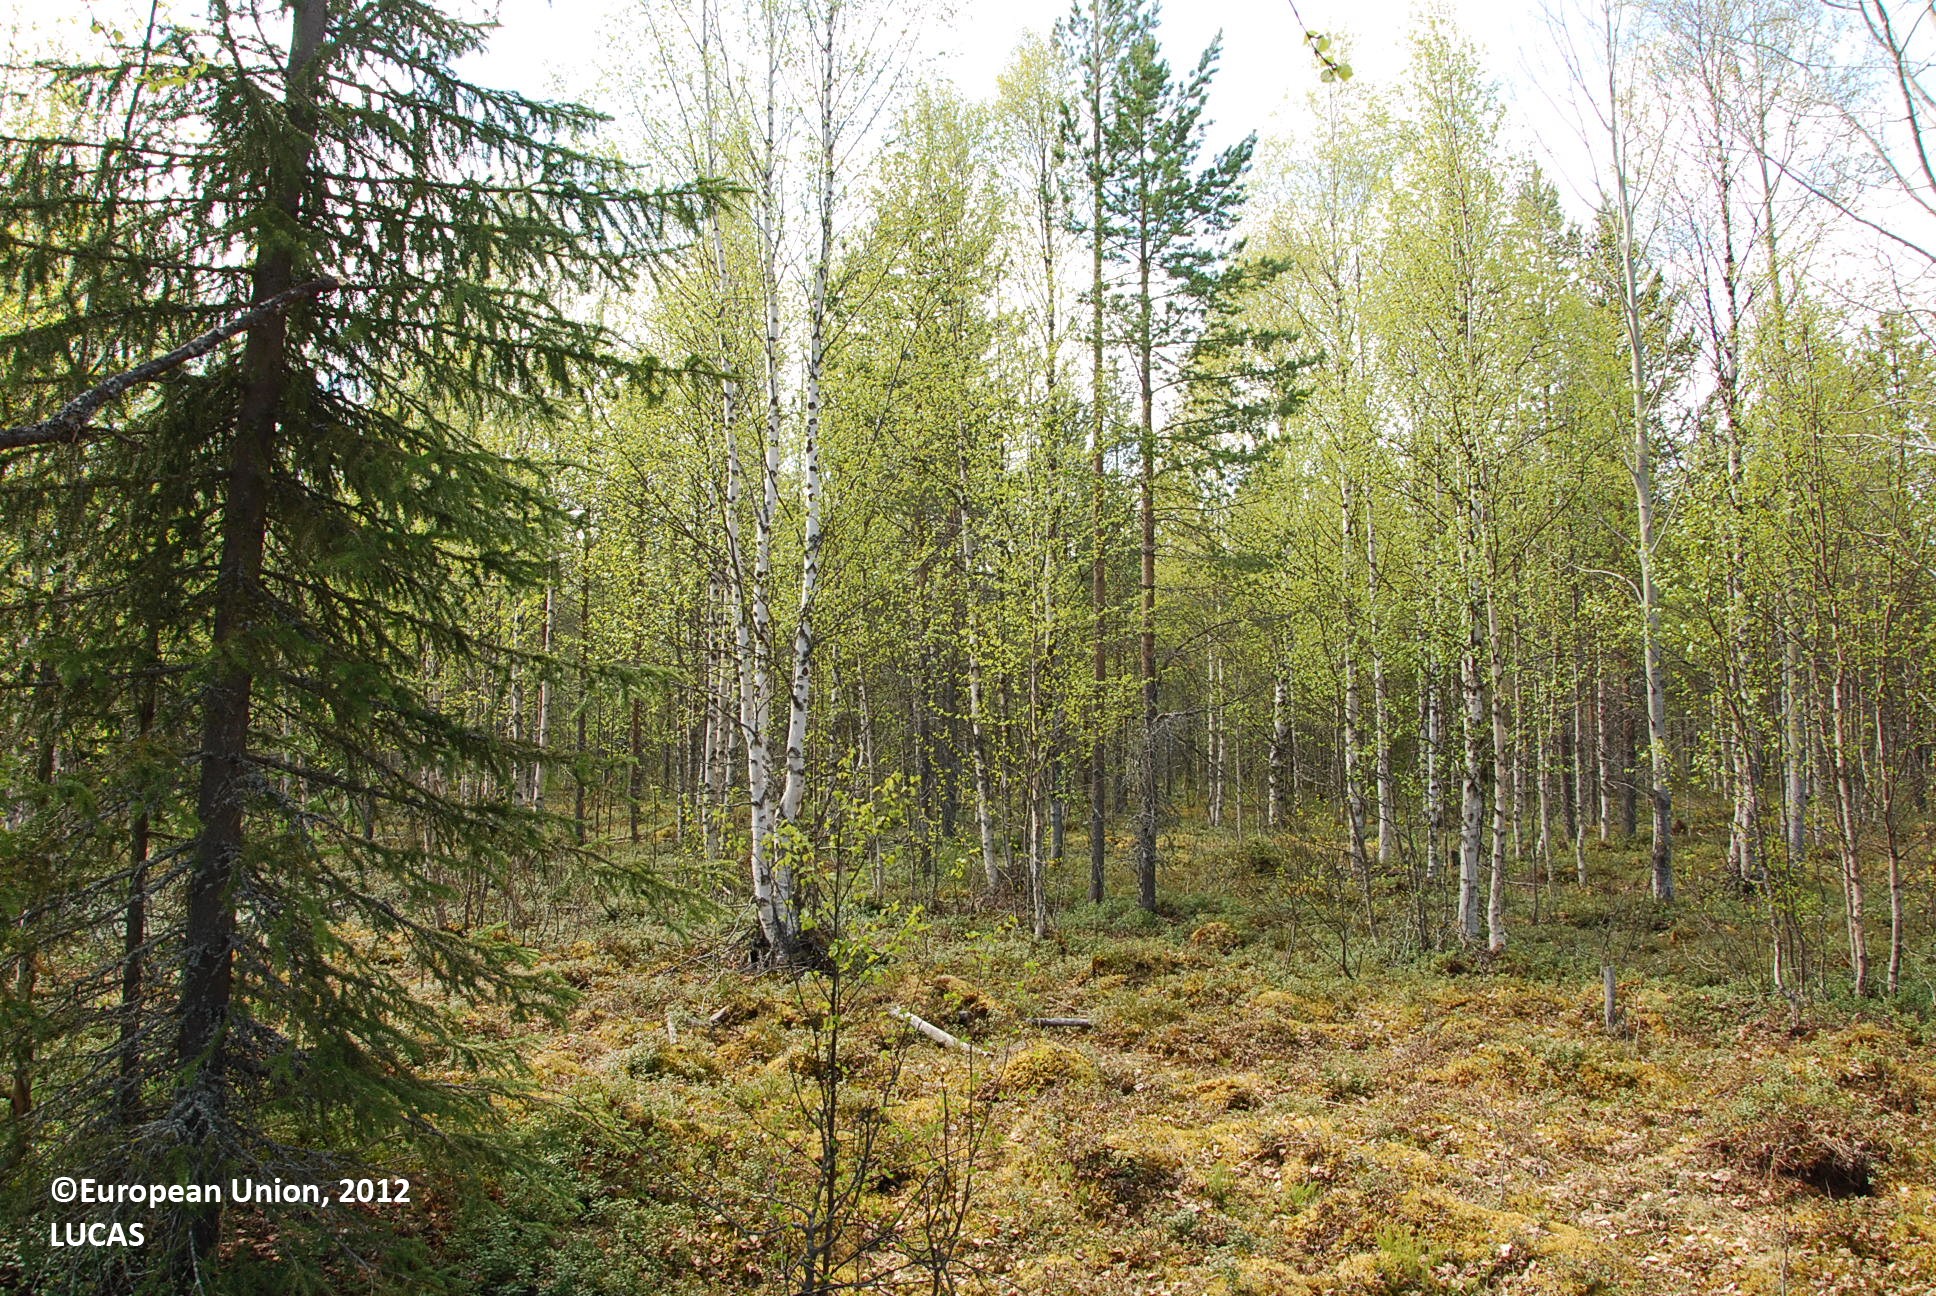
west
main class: Woodland
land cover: Broadleaved woodland
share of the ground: 50 - 75 %
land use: Forestry
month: June
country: FI
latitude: 66.9529
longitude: 28.2357
